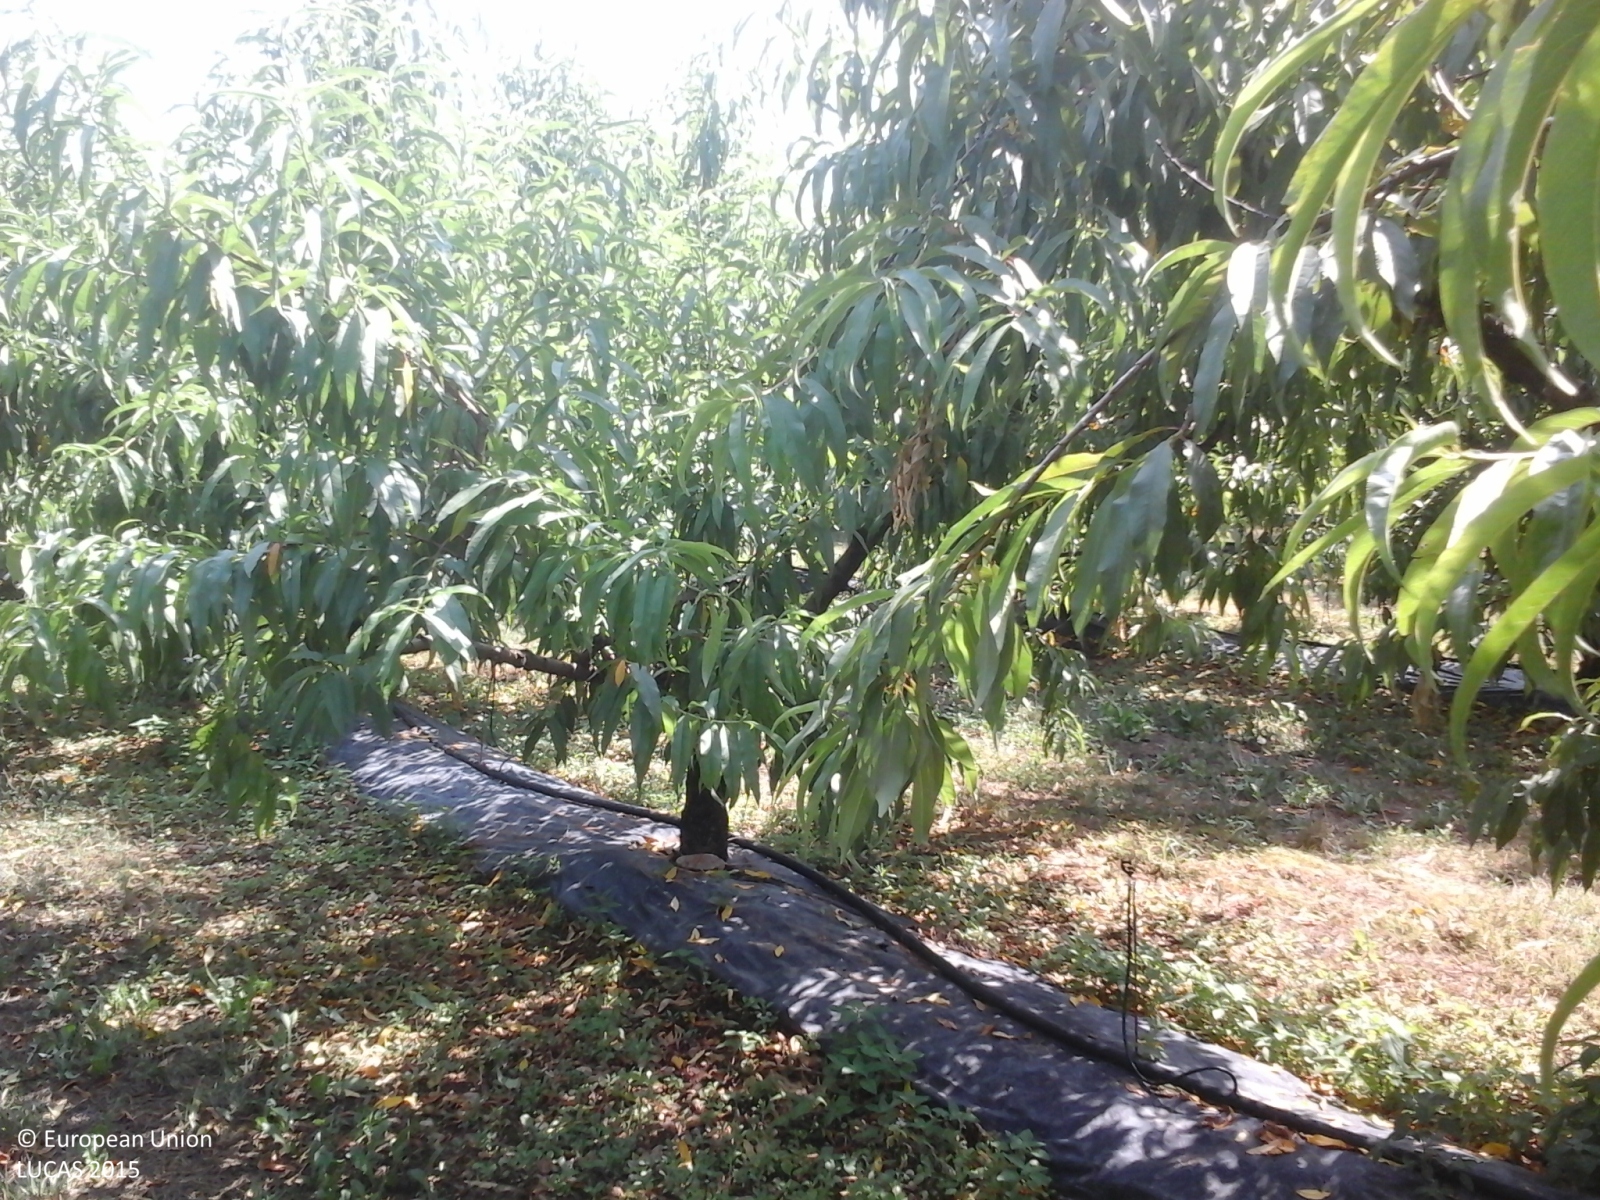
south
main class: Cropland
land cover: Other fruit trees and berries
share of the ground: > 75 %
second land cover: Grassland without tree/shrub cover
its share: > 75 %
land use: Agriculture (excluding fallow land and kitchen gardens)
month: July
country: IT
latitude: 45.2854
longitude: 10.7508
